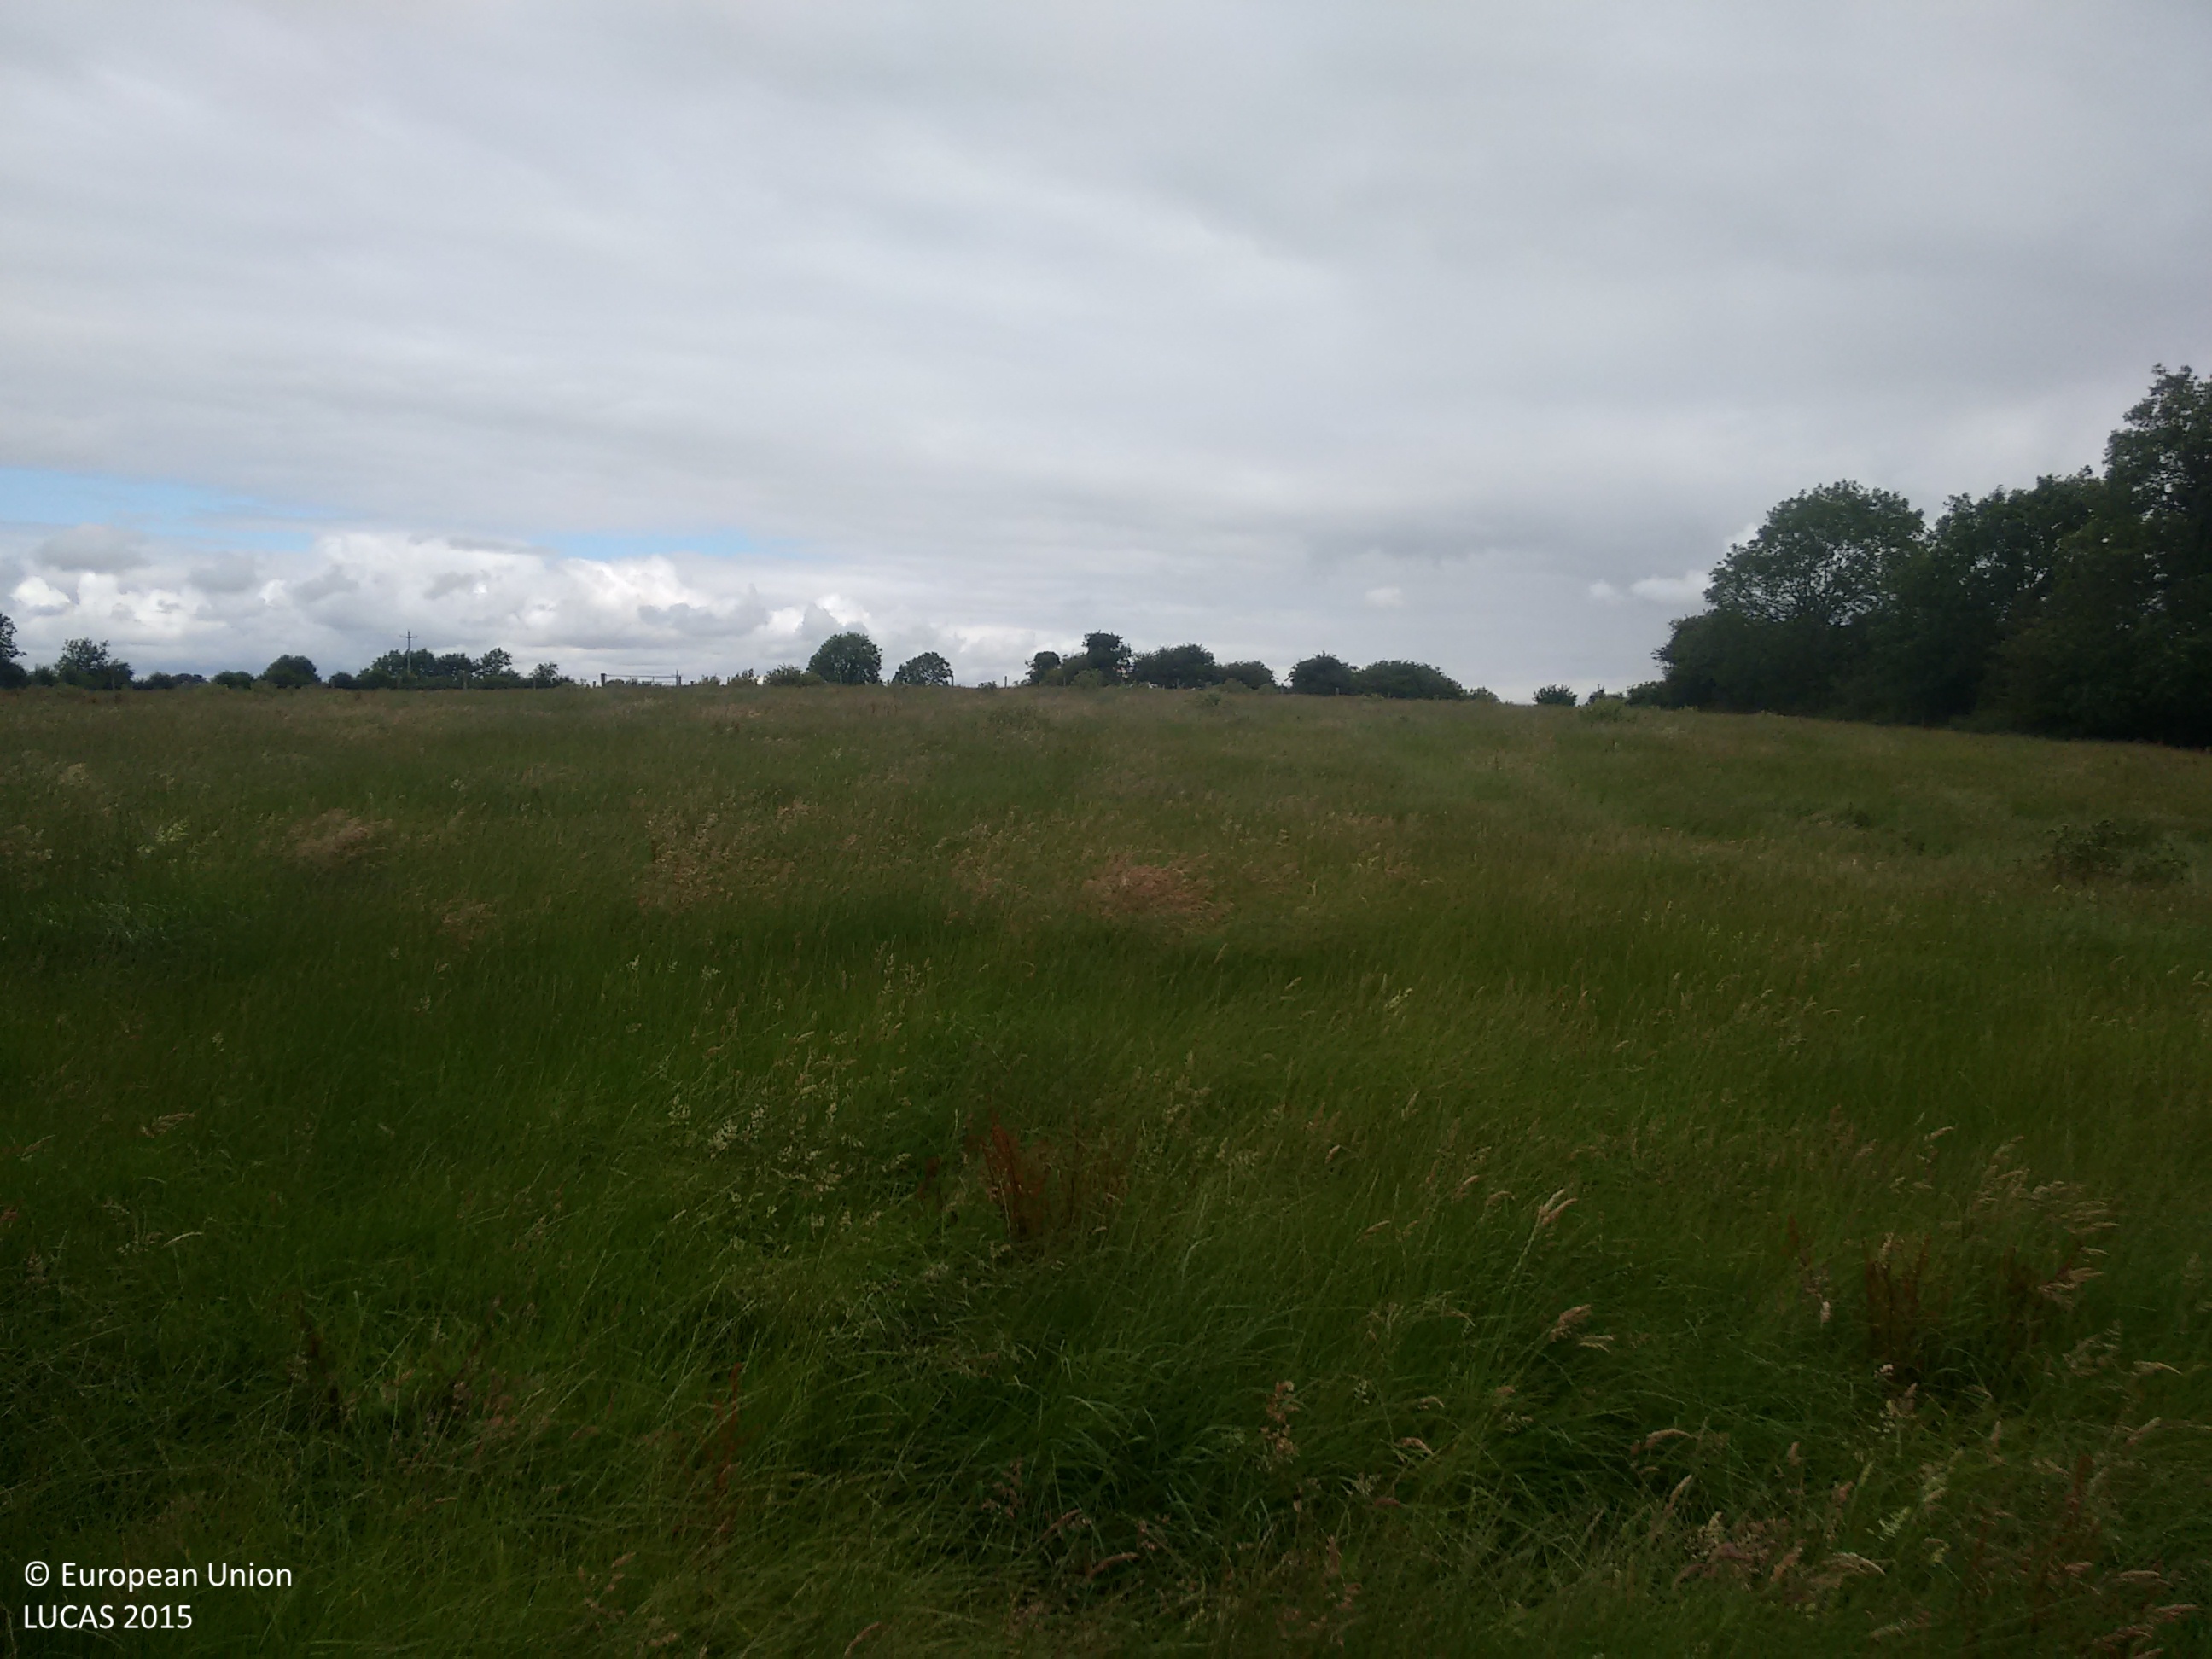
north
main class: Grassland
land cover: Grassland without tree/shrub cover
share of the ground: > 75 %
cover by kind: herbaceous plants 100 %
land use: Agriculture (excluding fallow land and kitchen gardens)
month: July
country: IE
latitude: 53.7181
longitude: -9.1759
